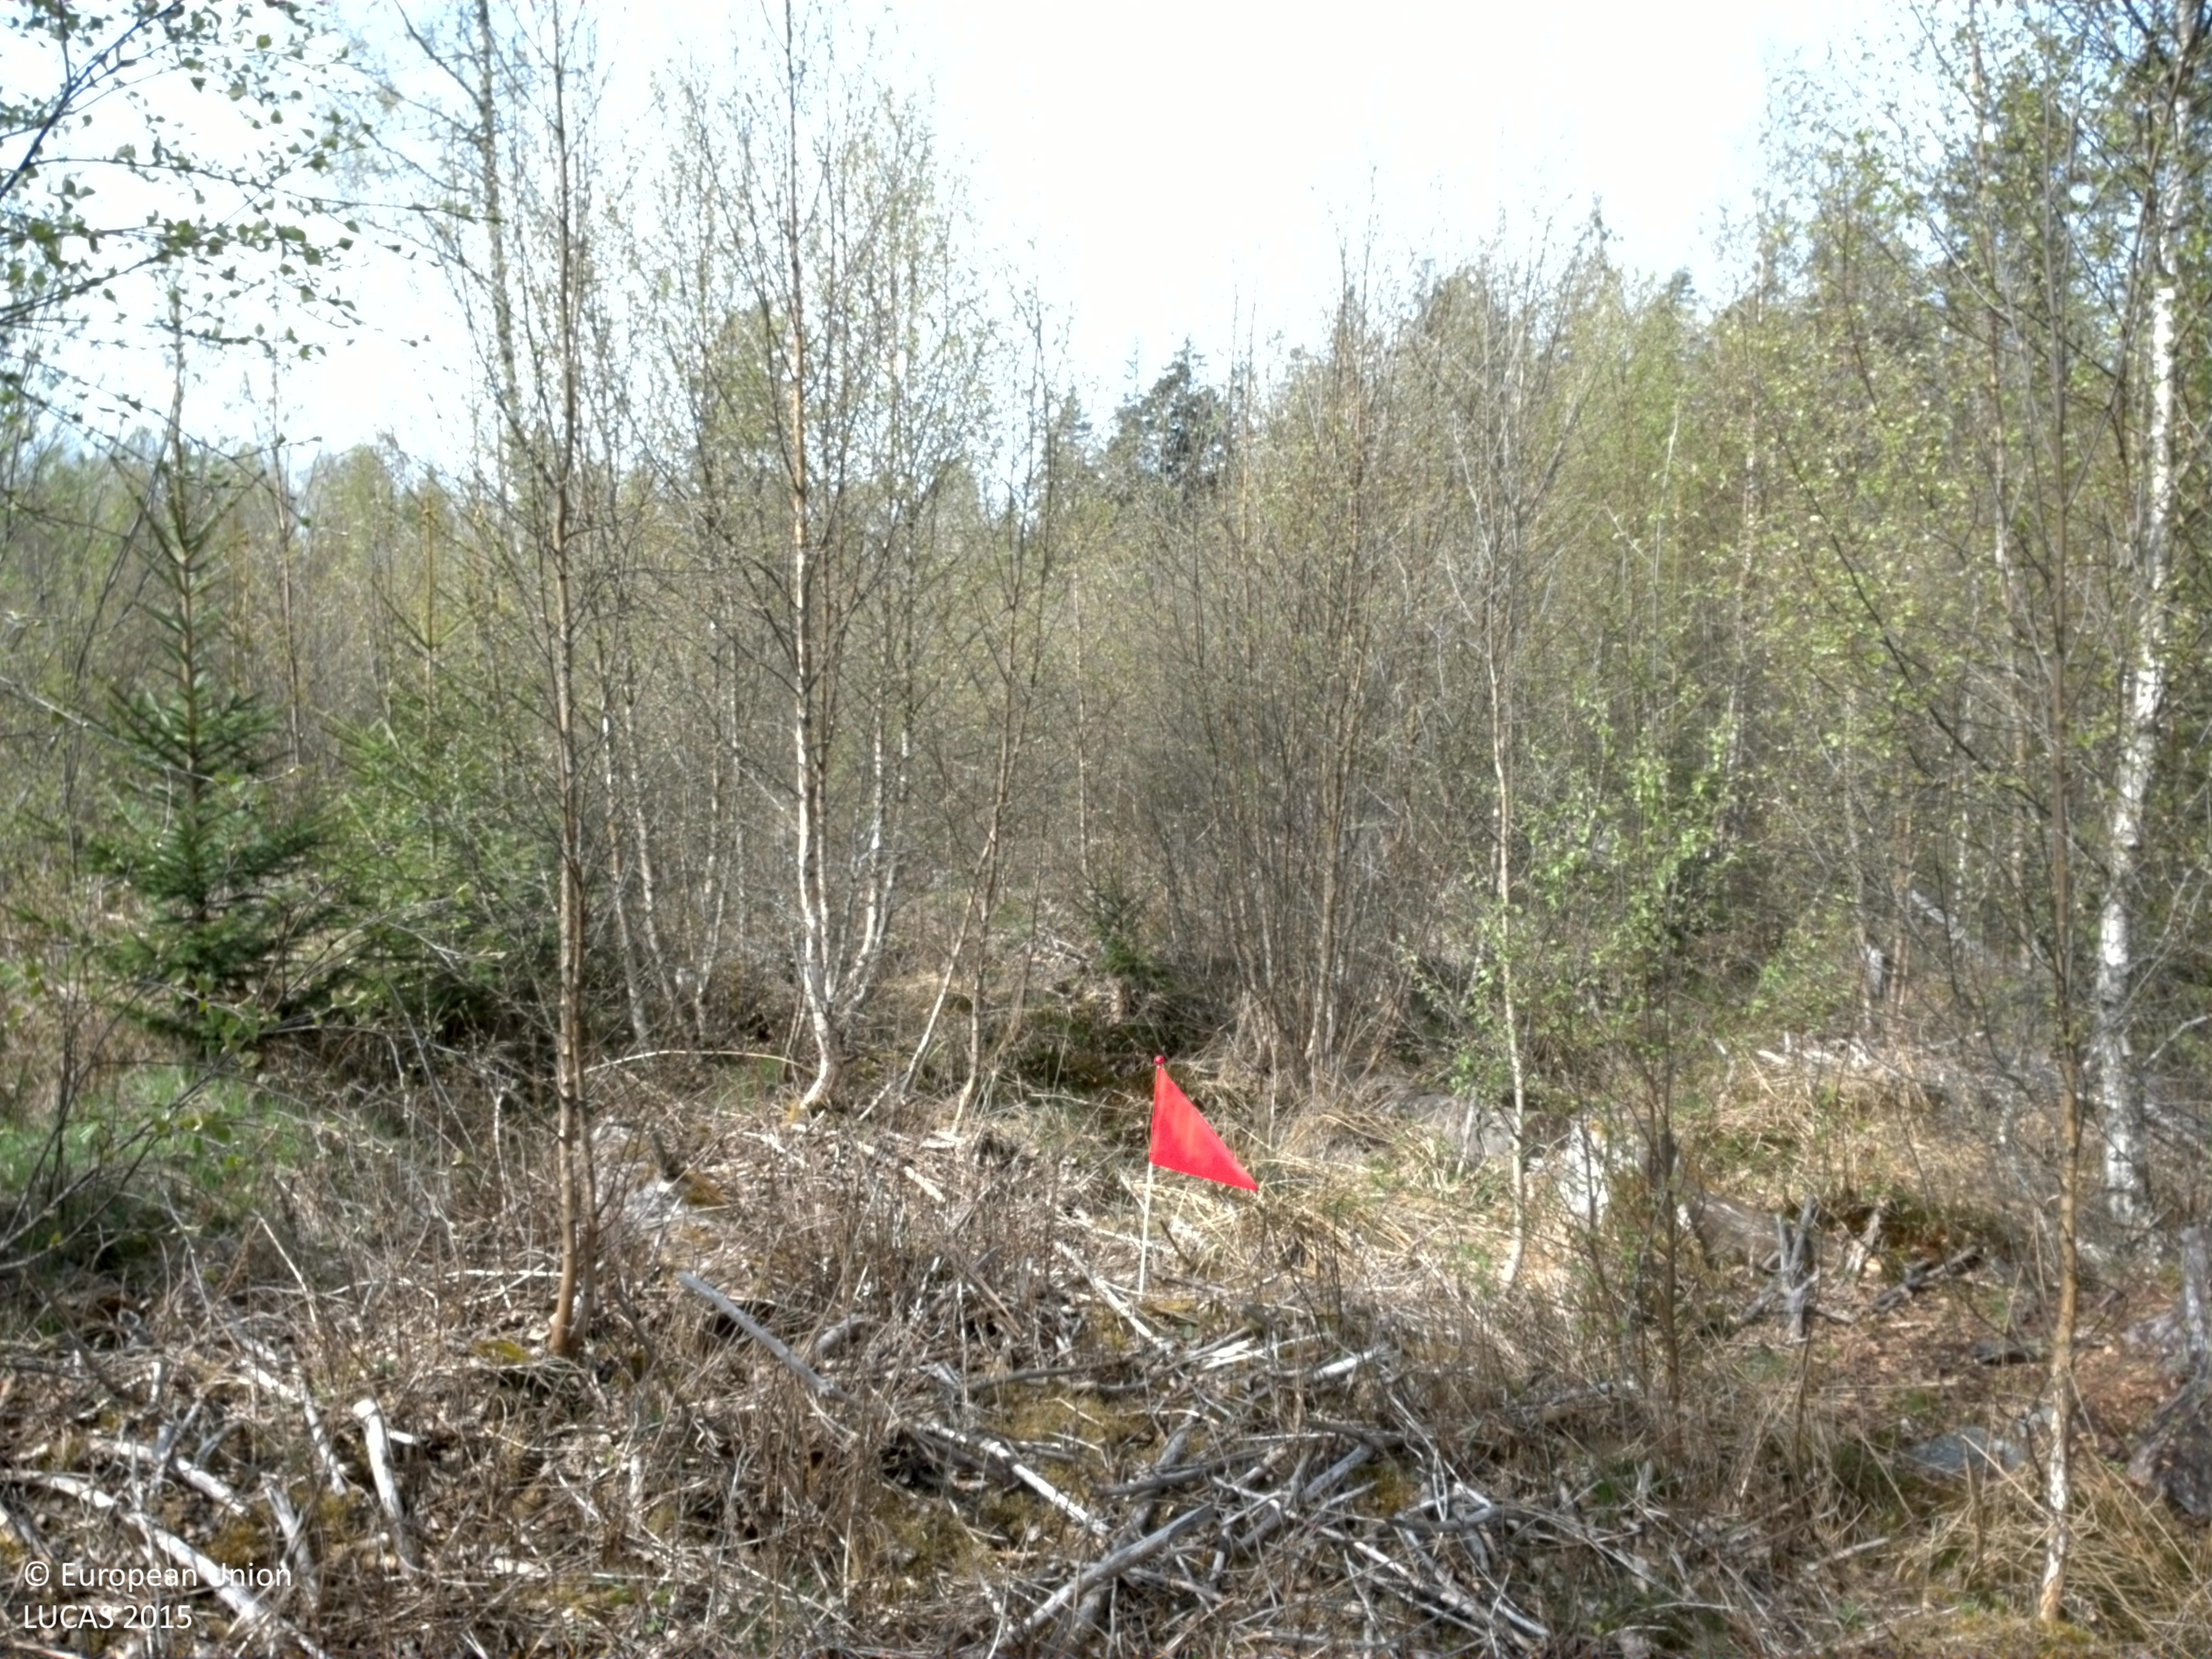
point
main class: Woodland
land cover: Broadleaved woodland
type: boreal forest
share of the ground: > 75 %
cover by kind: broadleaved forest trees 75 %, coniferous forest trees 15 %, shrubs 5 %, herbaceous plants 5 %
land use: Forestry
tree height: < 5 m
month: May
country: SE
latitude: 56.7995
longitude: 14.8278
